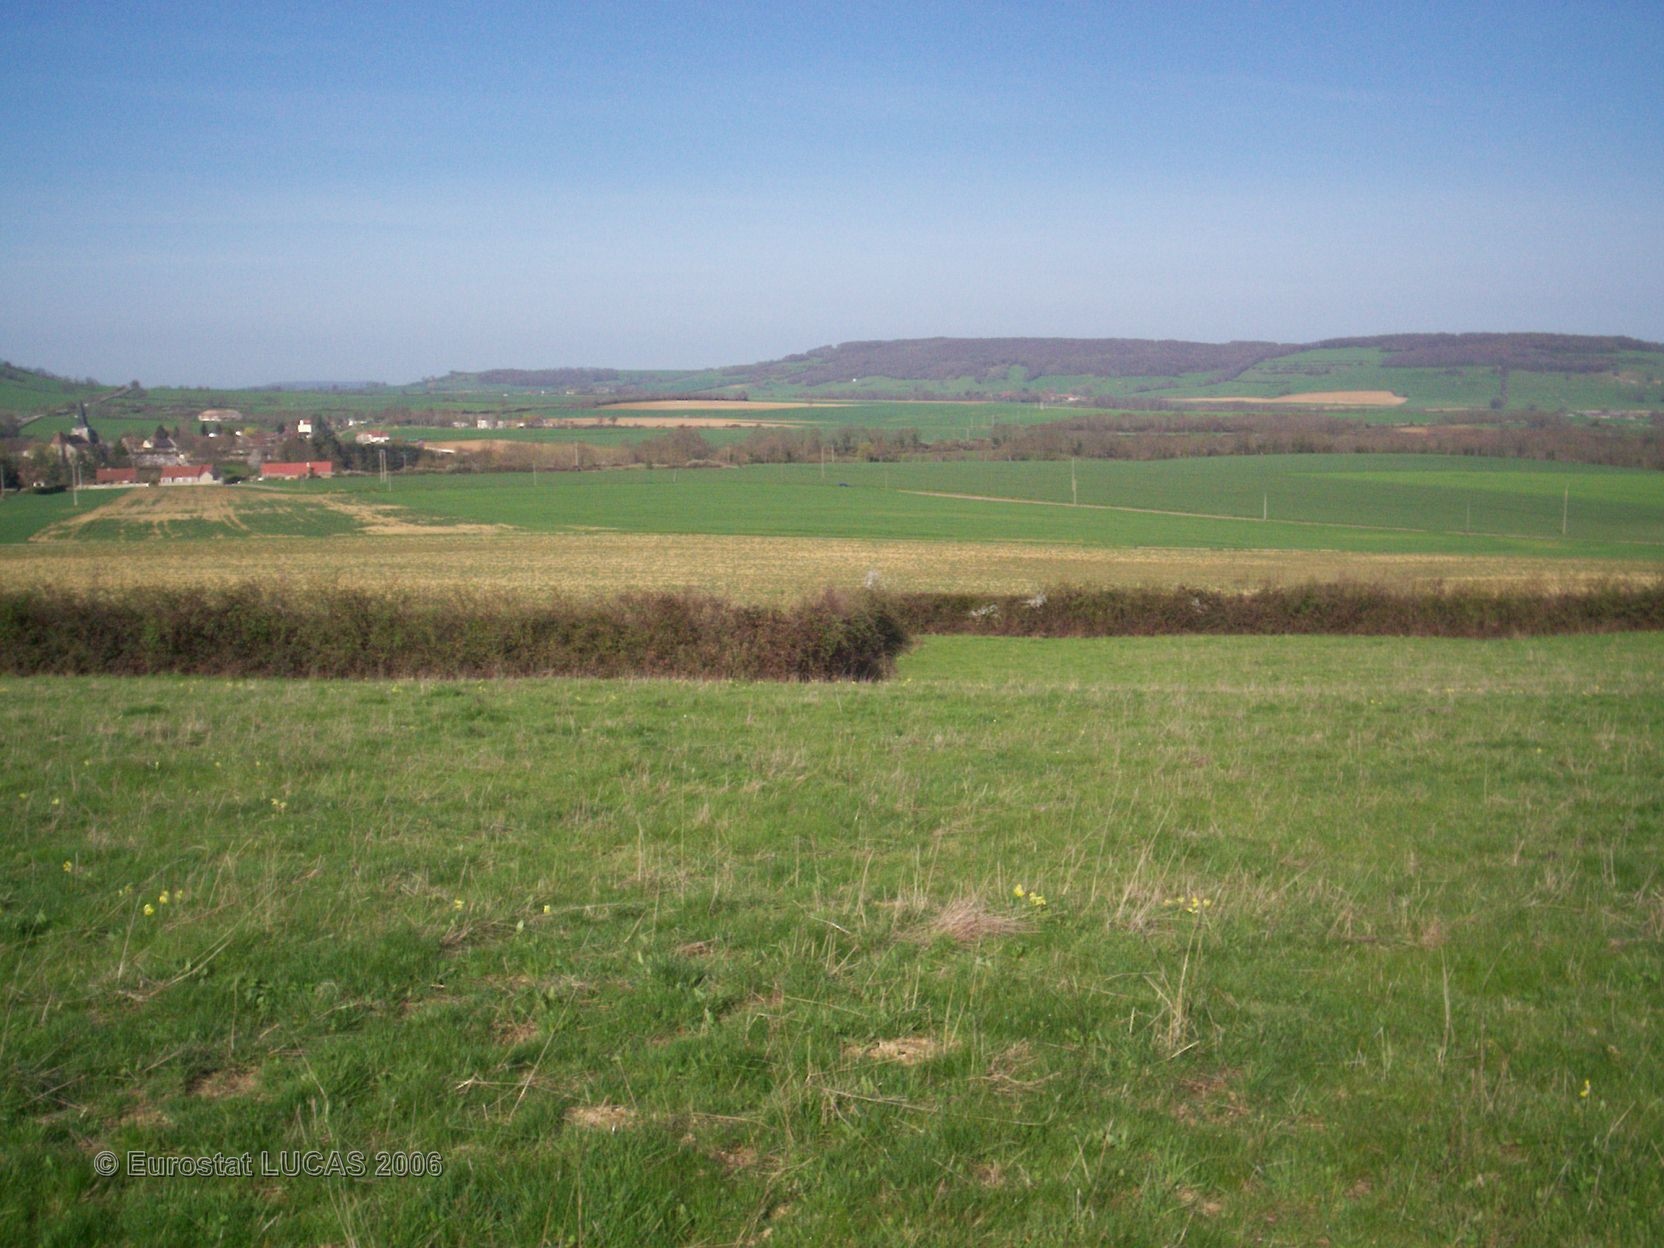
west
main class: Grassland
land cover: Grassland without tree/shrub cover
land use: Agriculture (excluding fallow land and kitchen gardens)
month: April
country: FR
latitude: 47.4035
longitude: 4.5532
